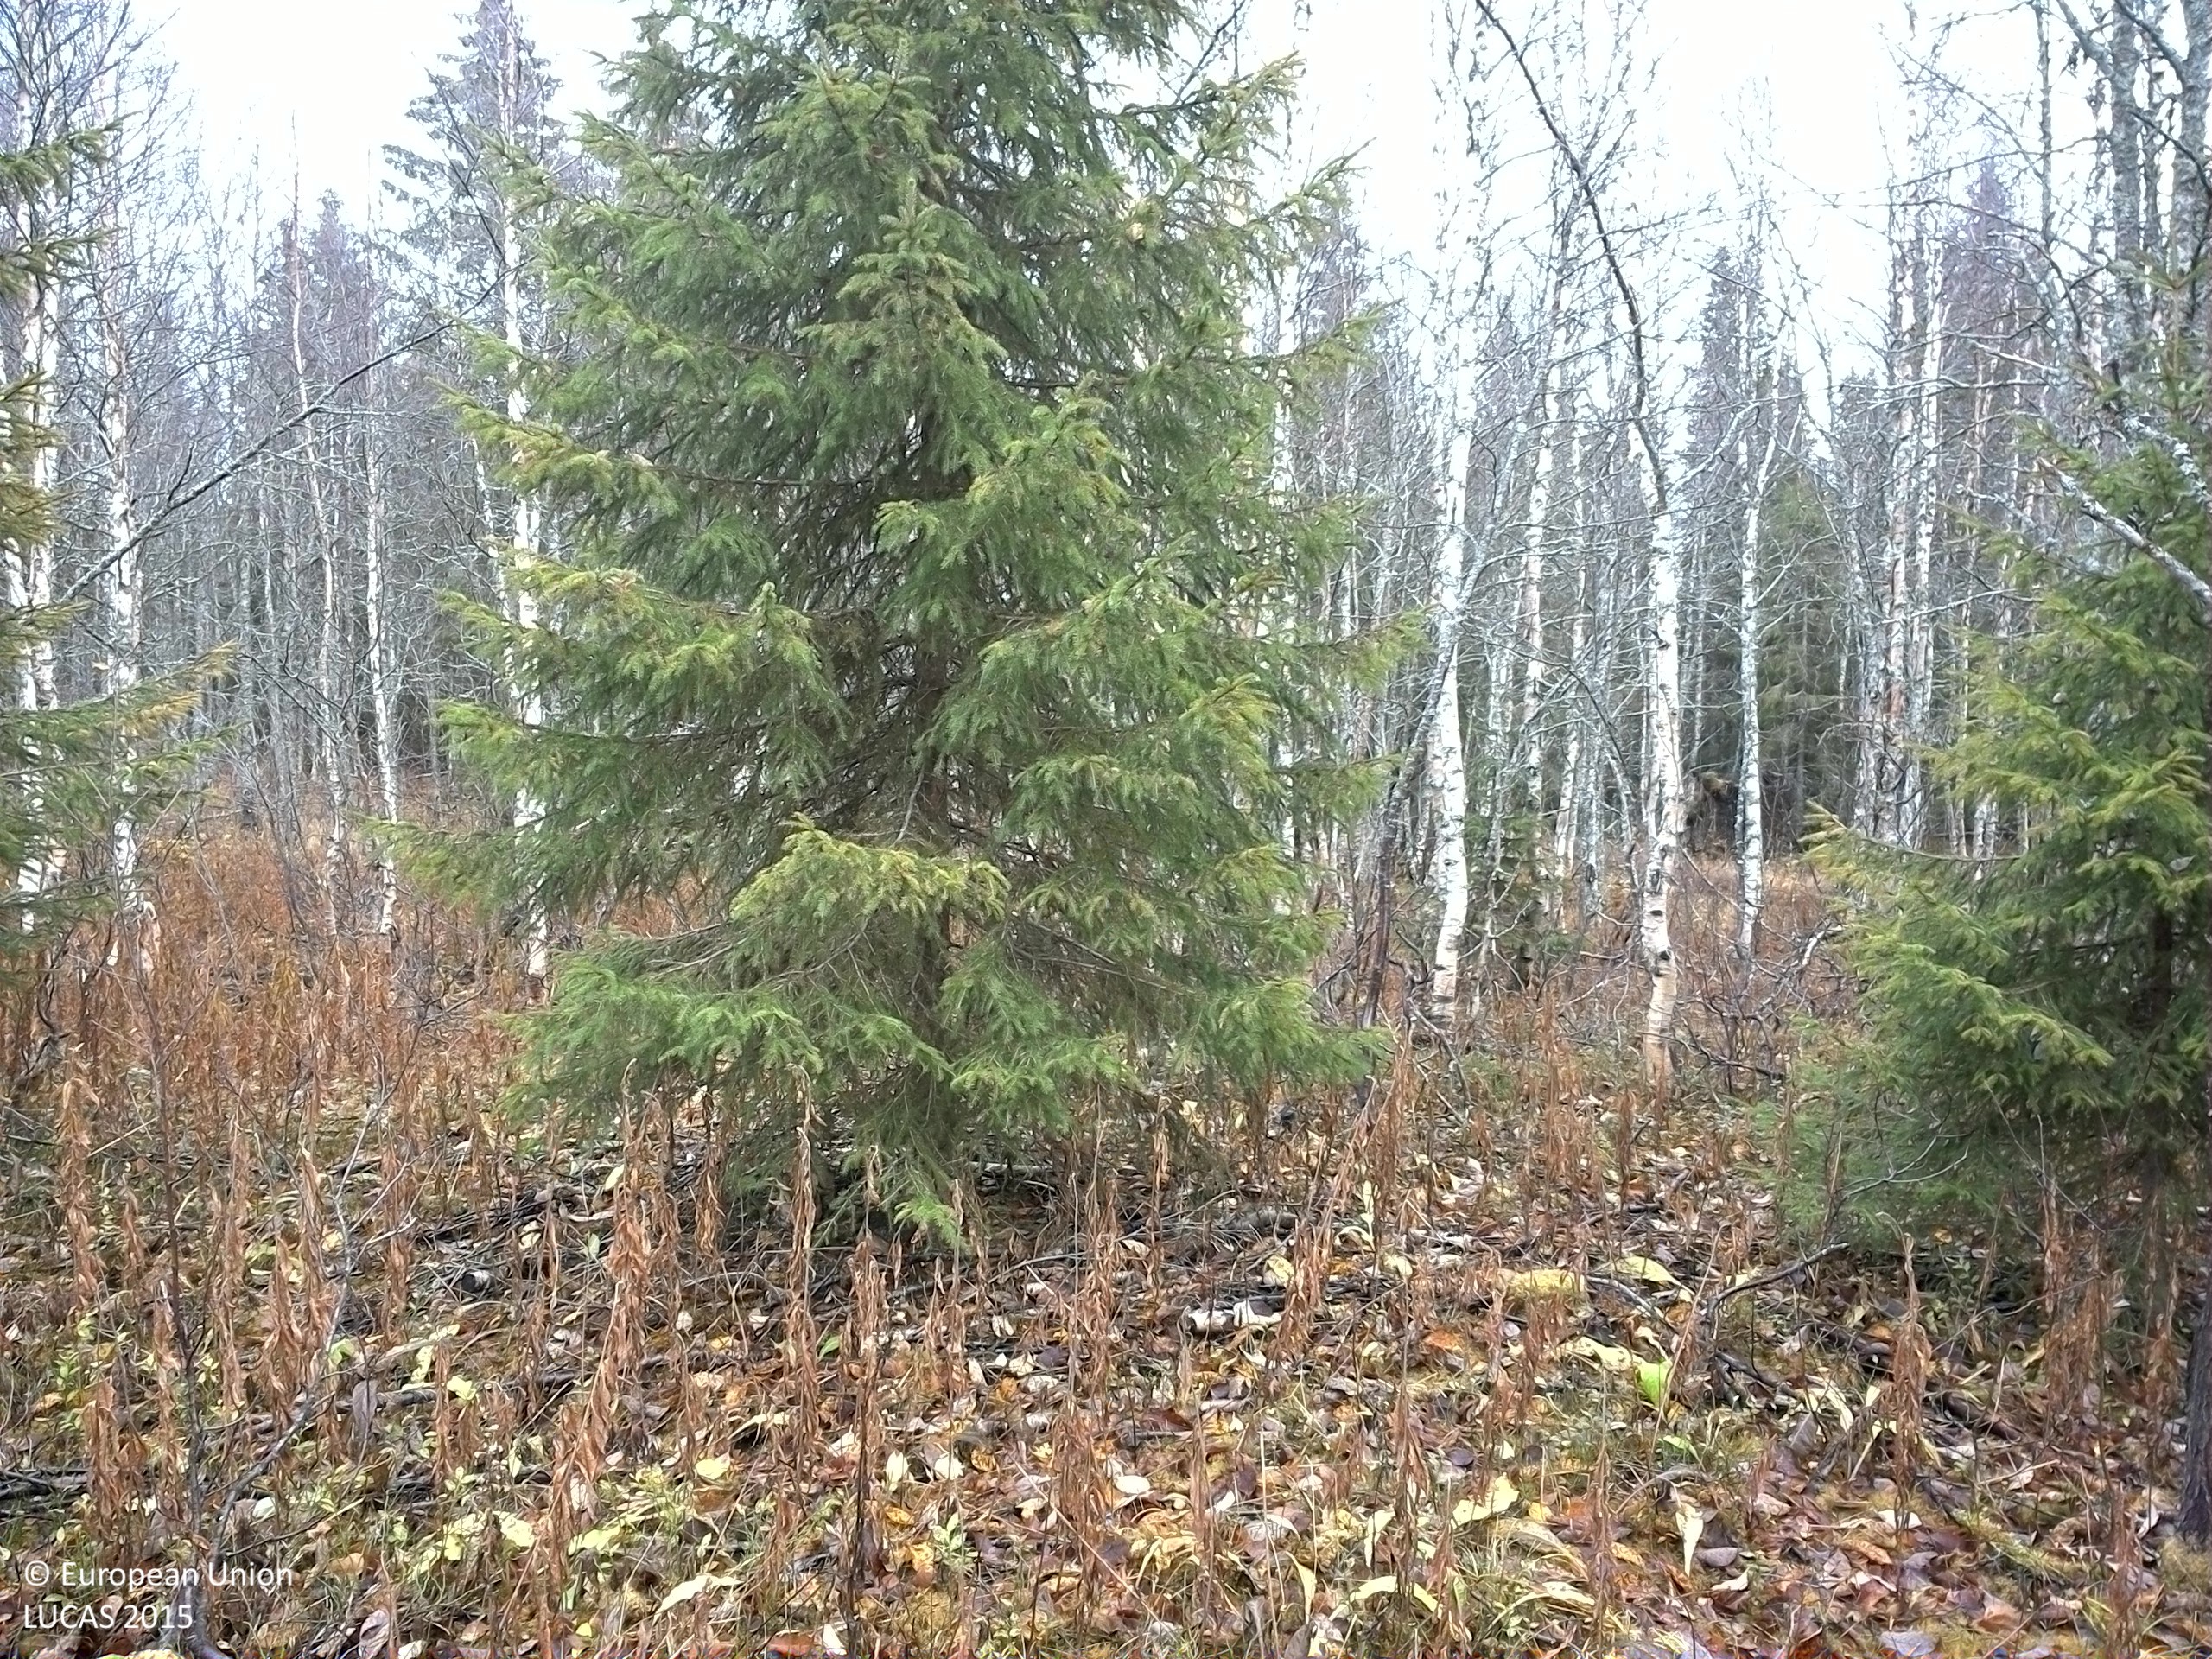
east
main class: Woodland
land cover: Spruce dominated mixed woodland
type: boreal forest
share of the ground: 50 - 75 %
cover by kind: broadleaved forest trees 55 %, coniferous forest trees 20 %, shrubs 15 %, lichens and mosses 10 %
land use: Forestry
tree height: > 5 m
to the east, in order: Spruce dominated mixed woodland; Rivers and streams; Broadleaved woodland; Spruce dominated mixed woodland; Grassland without tree/shrub cover; Electric lines; Grassland without tree/shrub cover; Rivers and streams; Spruce dominated mixed woodland; Spruce dominated coniferous woodland; Rivers and streams; Spruce dominated coniferous woodland
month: October
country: SE
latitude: 64.7277
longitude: 13.9848
